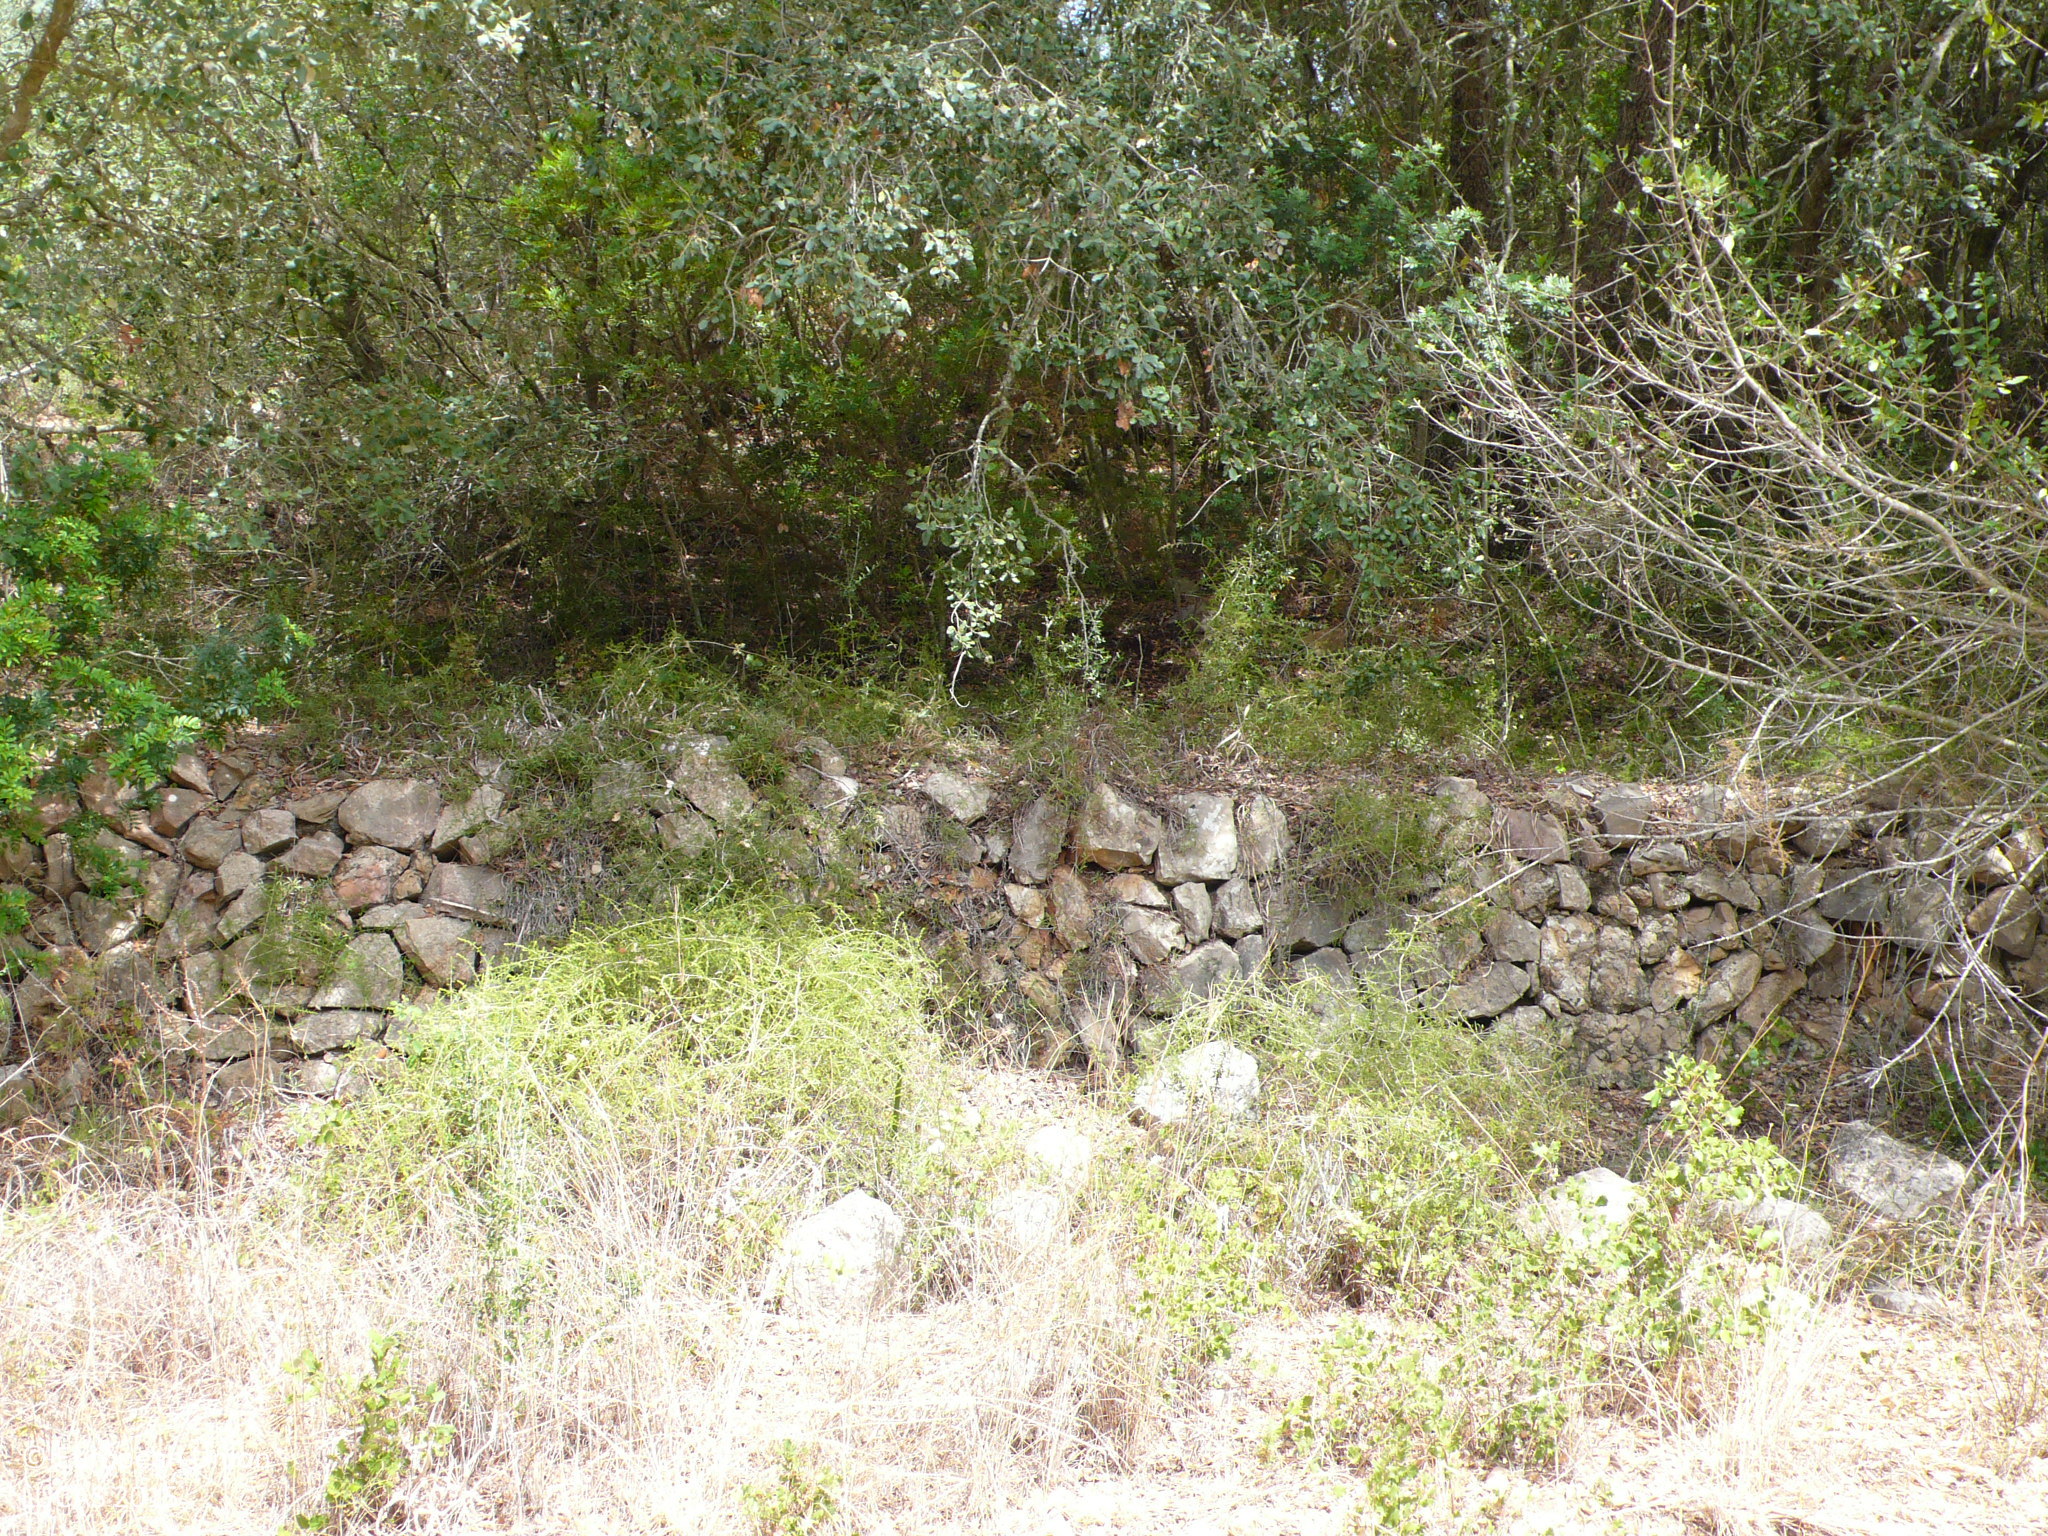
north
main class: Cropland
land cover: Barley
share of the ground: 25 - 50 %
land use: Agriculture (excluding fallow land and kitchen gardens)
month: August
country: ES
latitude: 39.5944
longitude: 2.4498
